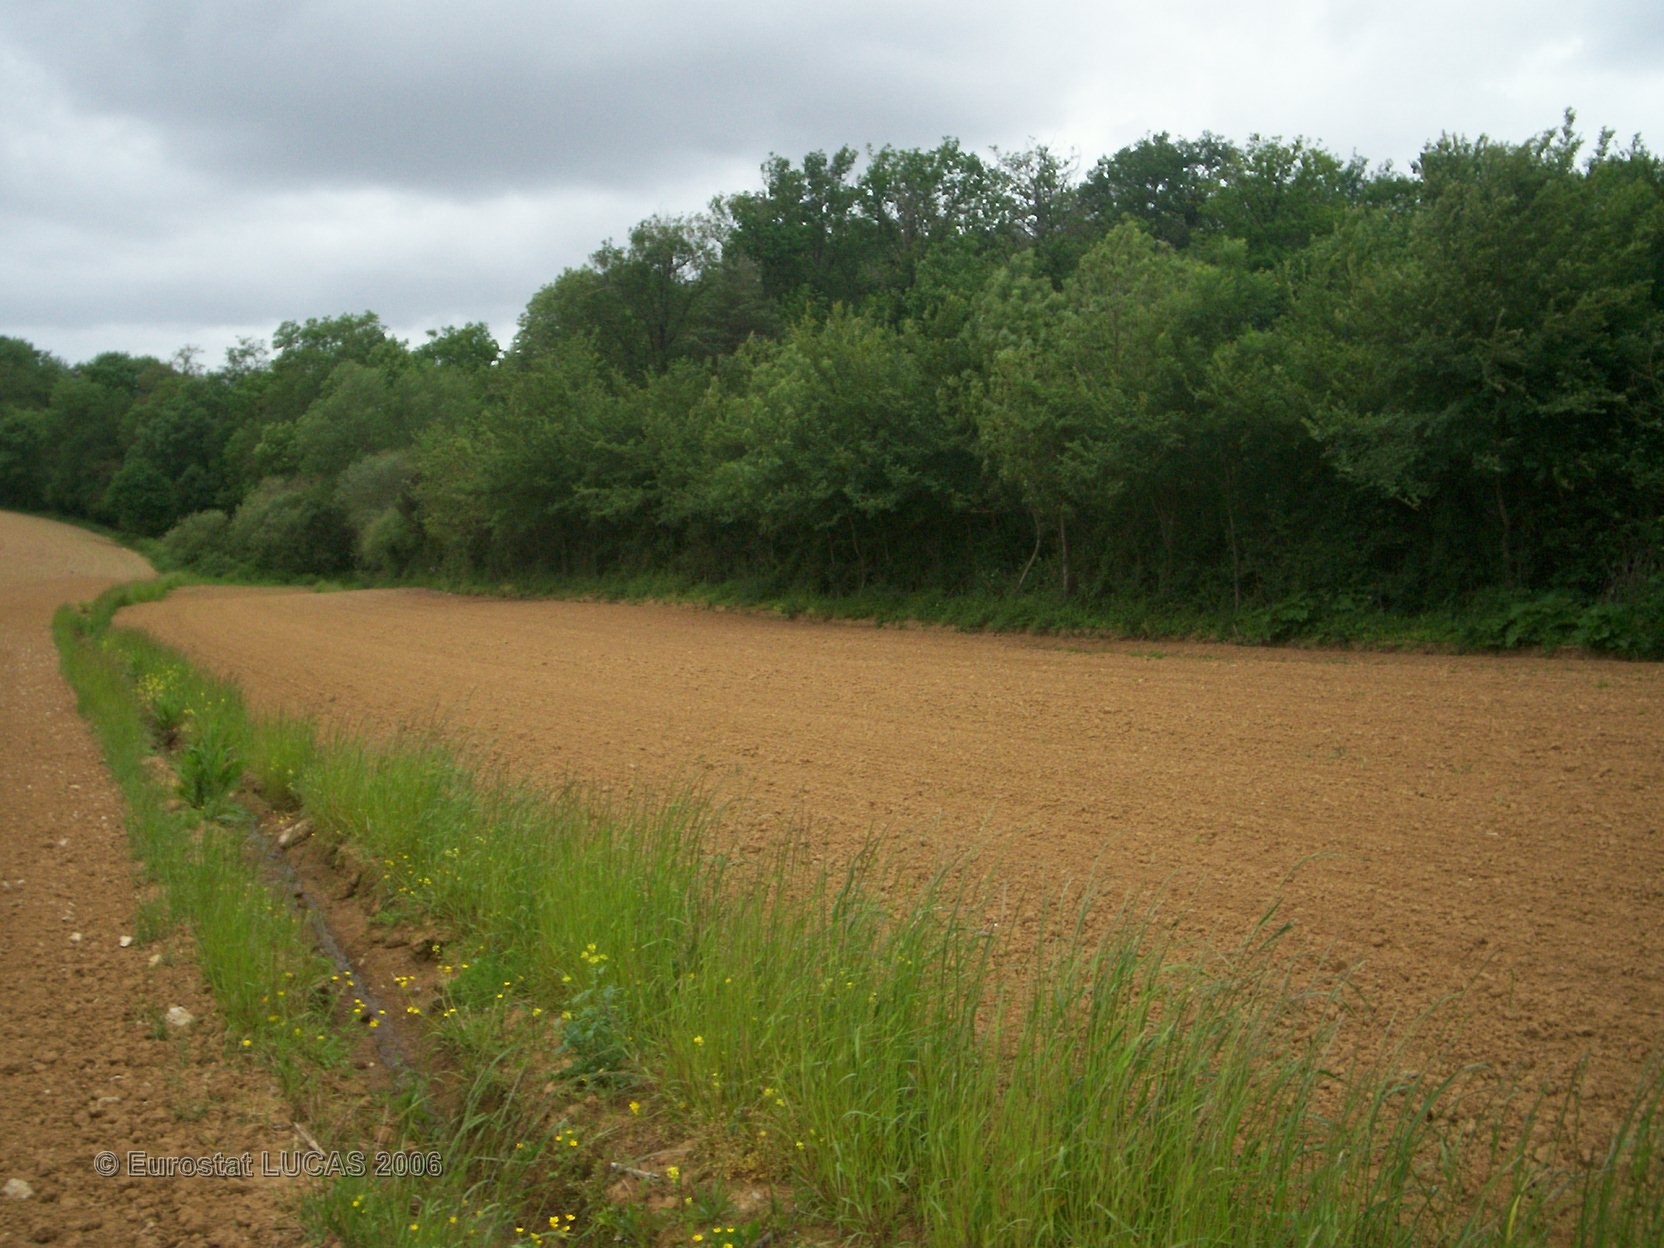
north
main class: Grassland
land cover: Grassland without tree/shrub cover
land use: Agriculture (excluding fallow land and kitchen gardens)
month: May
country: FR
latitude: 46.5077
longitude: -0.8337
